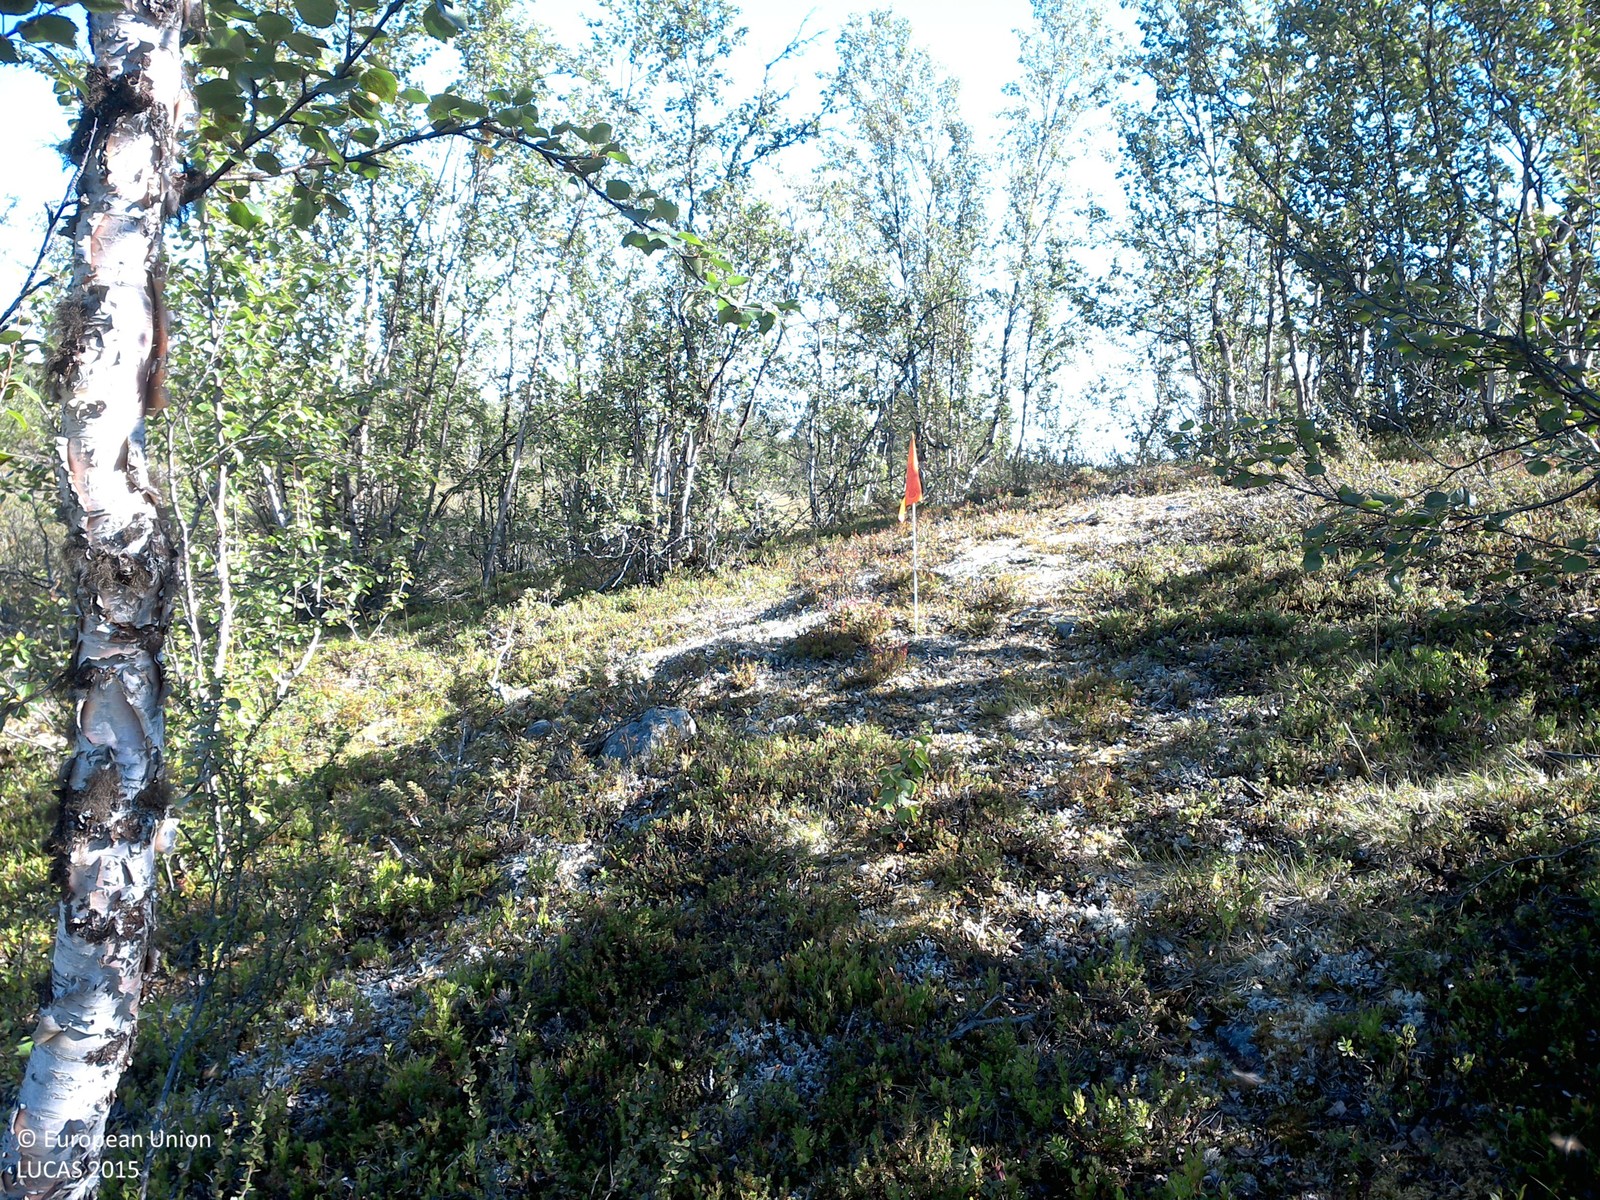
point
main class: Woodland
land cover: Broadleaved woodland
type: boreal forest
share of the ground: 10 - 25 %
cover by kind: shrubs 65 %, broadleaved forest trees 15 %, lichens and mosses 15 %, coniferous forest trees 5 %
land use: Amenities, museums, leisure
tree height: < 5 m
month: August
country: SE
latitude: 67.5457
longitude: 20.1013
